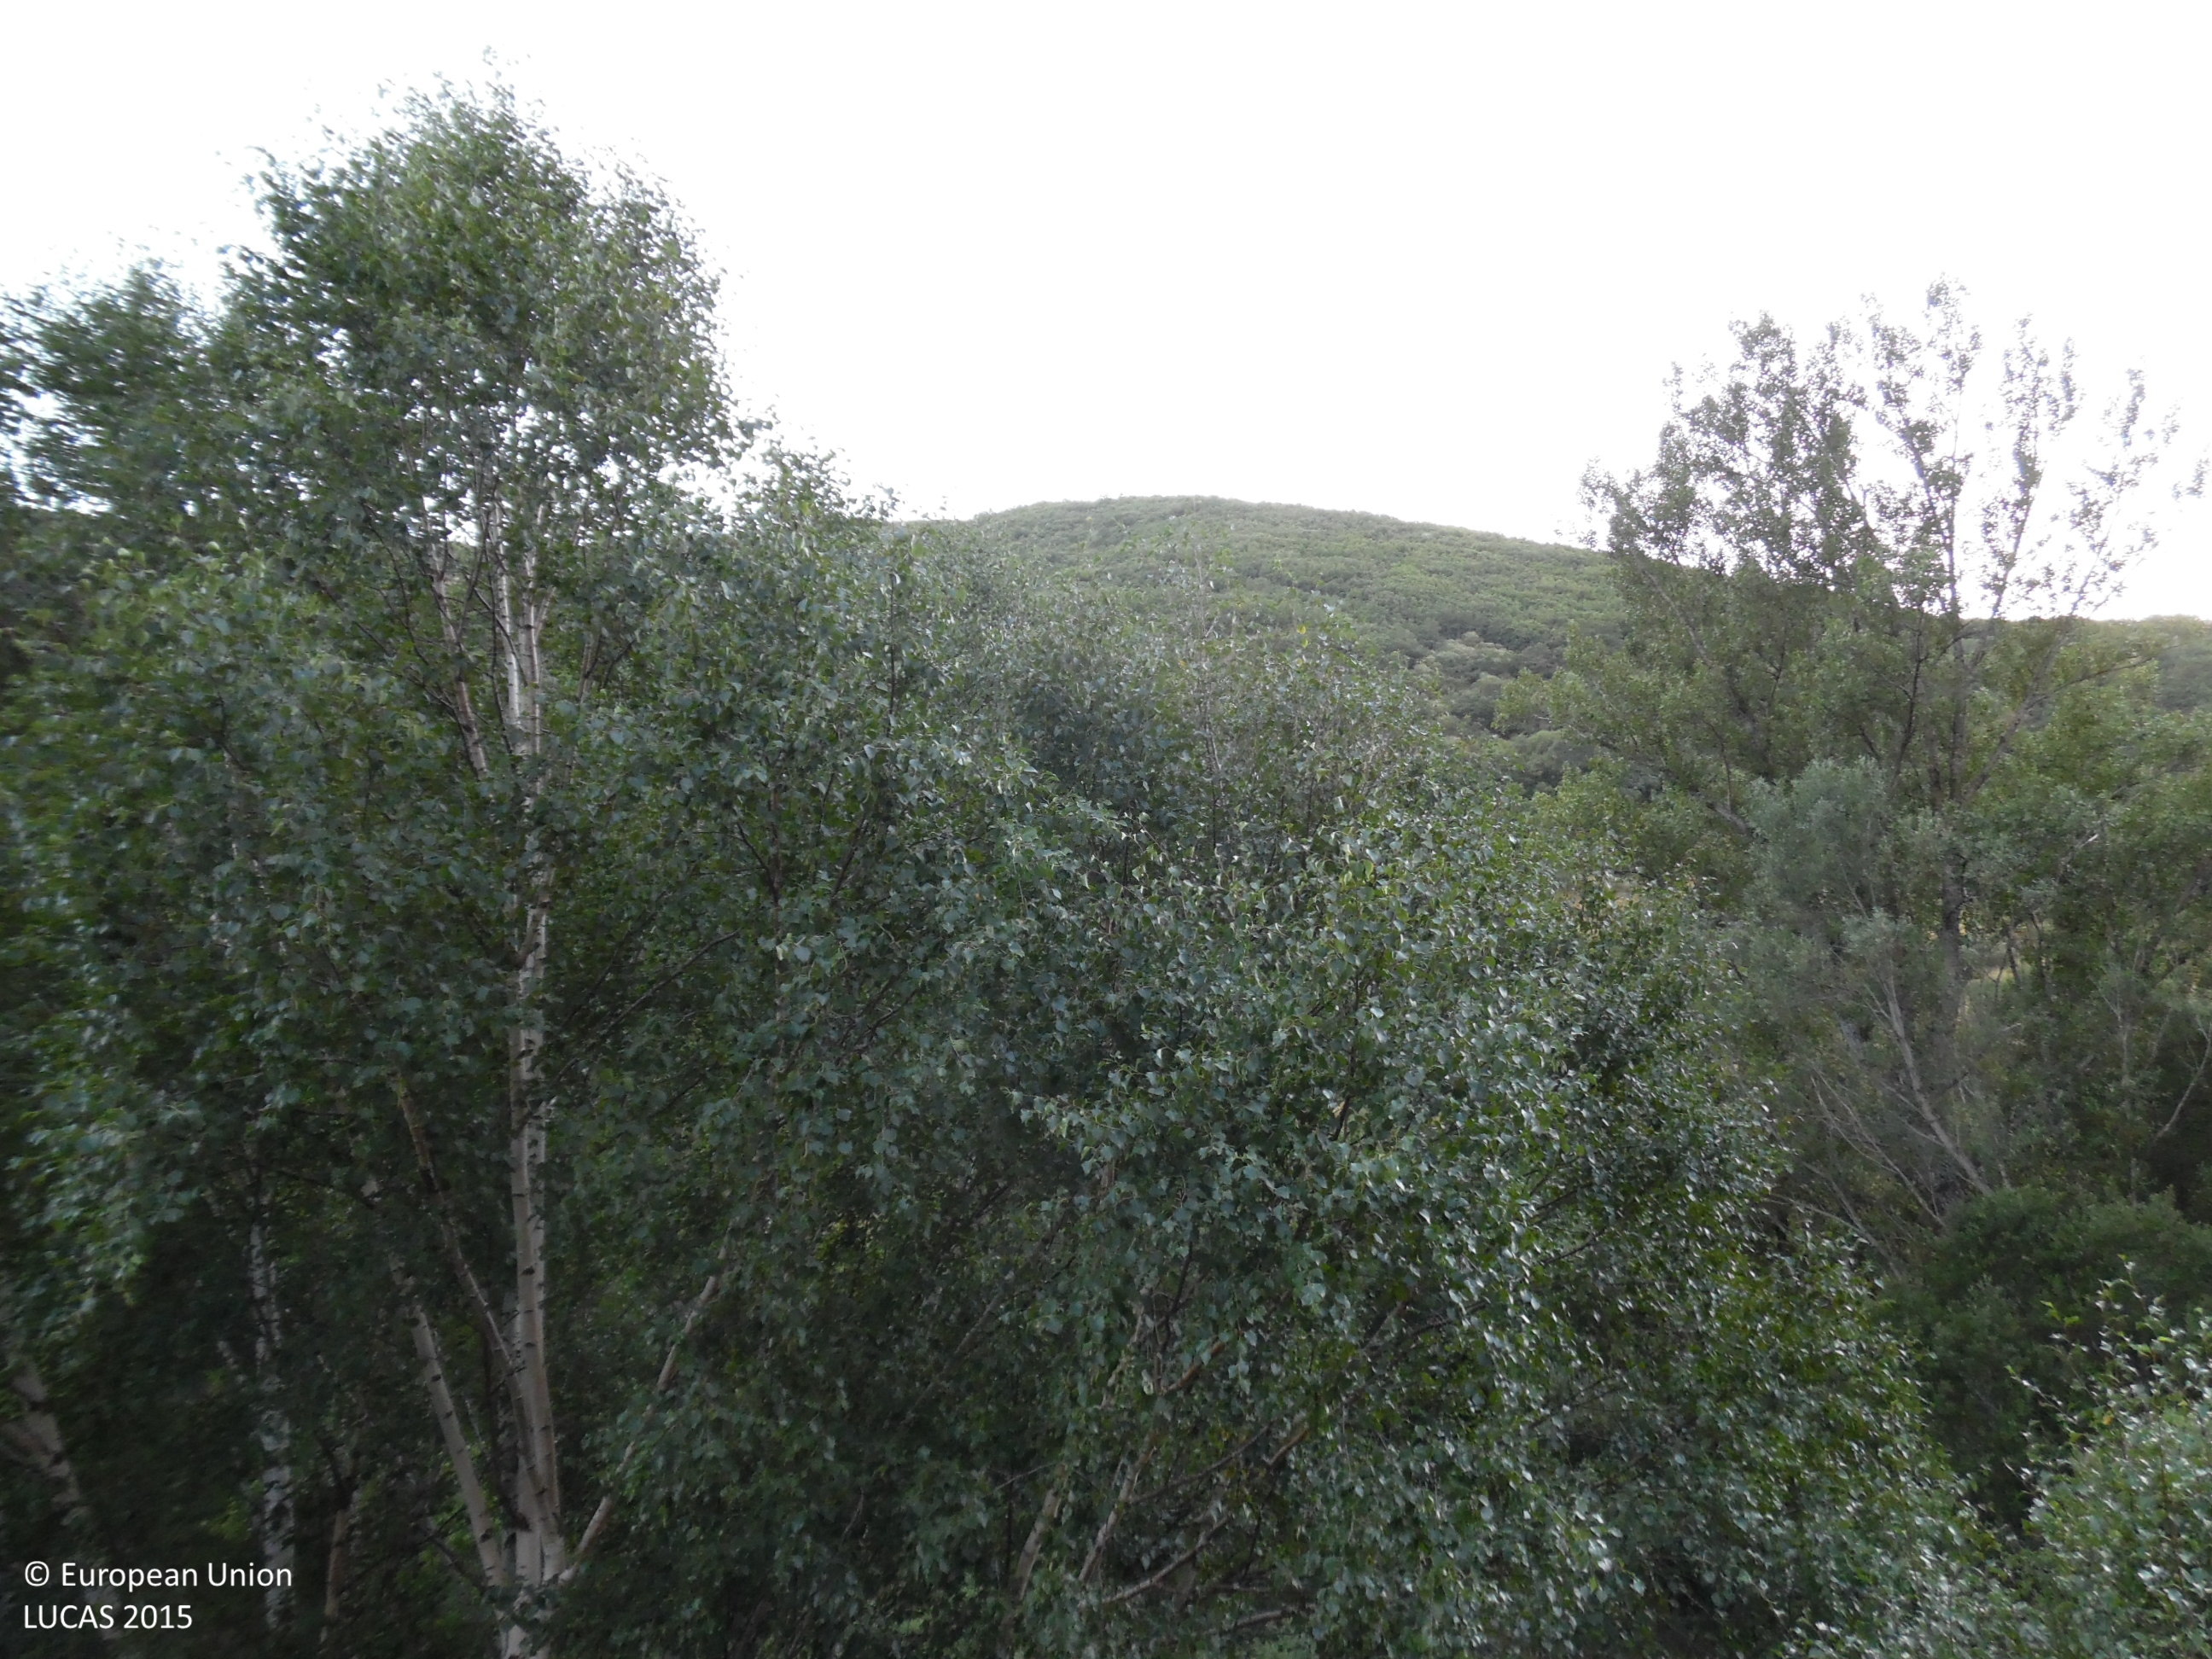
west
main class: Shrubland
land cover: Shrubland with sparse tree cover
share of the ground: > 75 %
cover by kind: shrubs 95 %, broadleaved forest trees 5 %
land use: Agriculture (excluding fallow land and kitchen gardens)
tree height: > 5 m
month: July
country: ES
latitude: 42.8362
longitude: -6.1520
